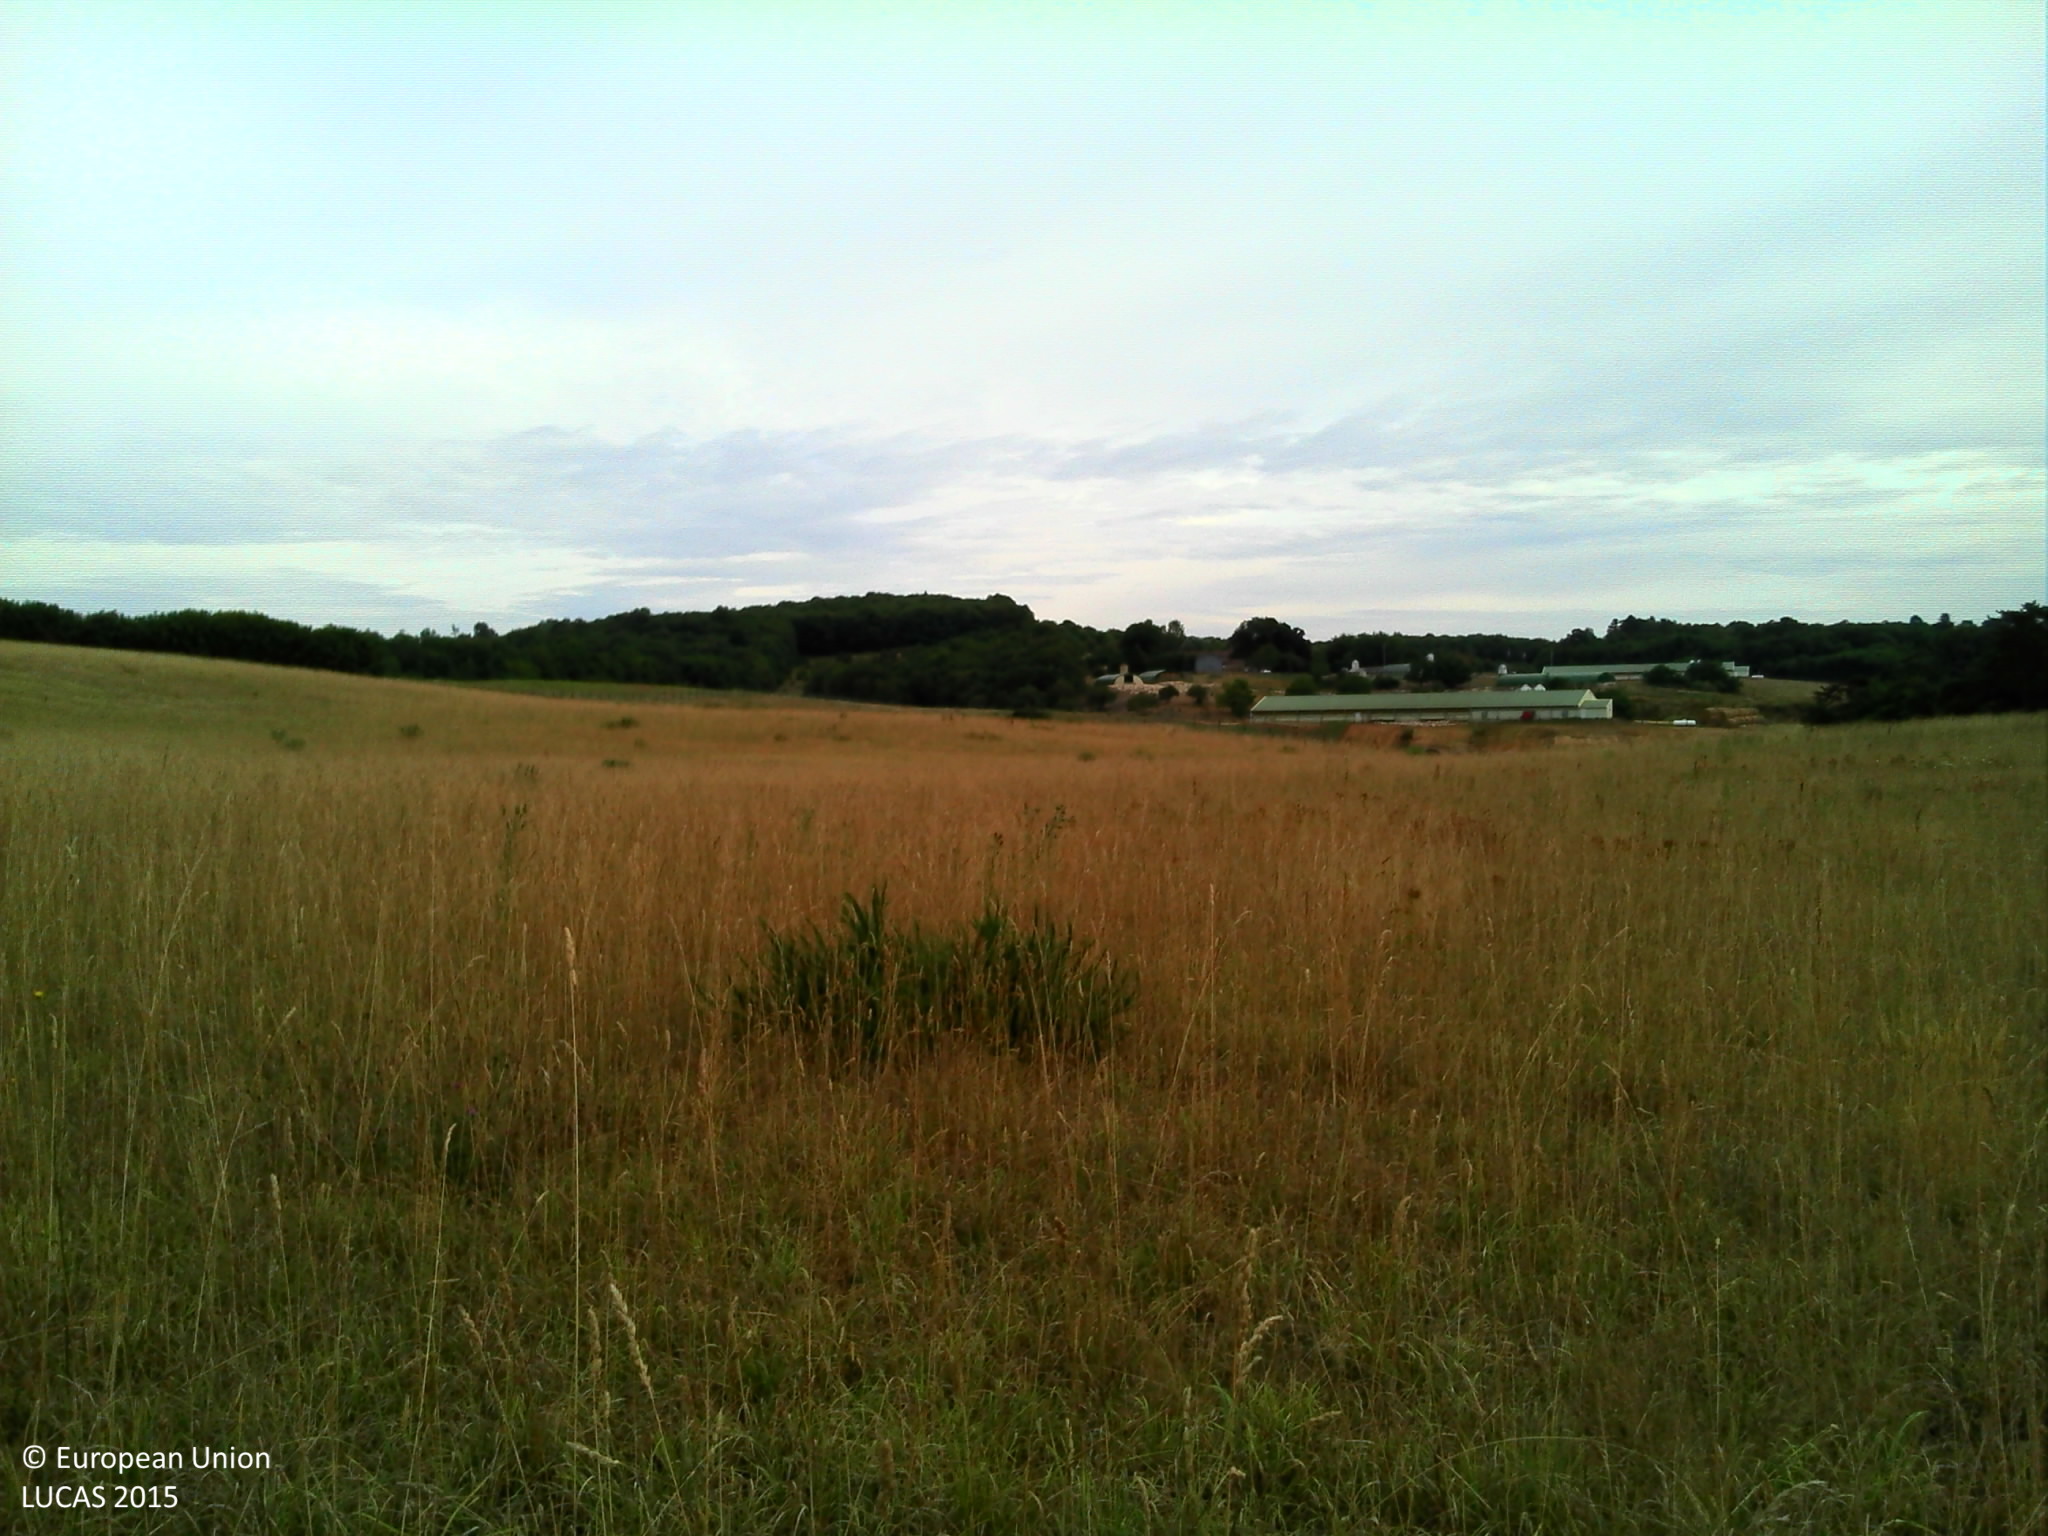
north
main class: Grassland
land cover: Grassland without tree/shrub cover
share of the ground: > 75 %
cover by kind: herbaceous plants 100 %
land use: Agriculture (excluding fallow land and kitchen gardens)
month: July
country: FR
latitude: 44.9771
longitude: 0.8236
